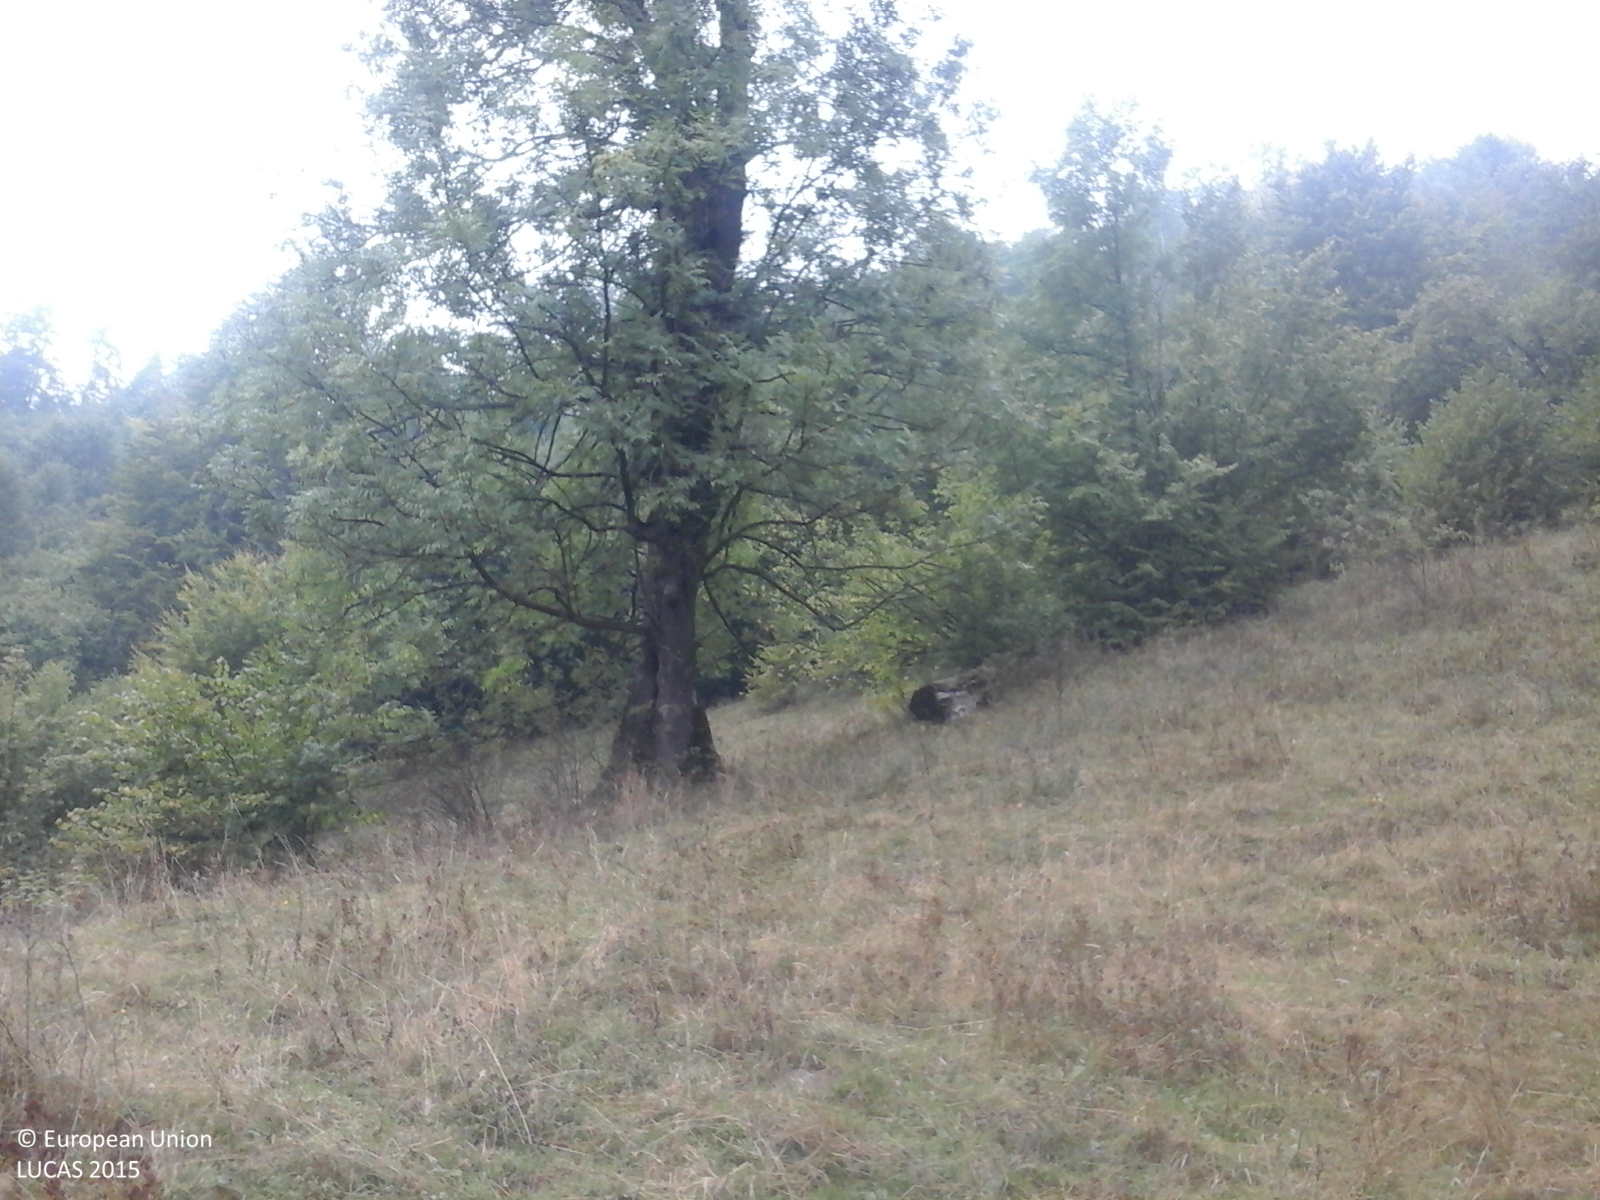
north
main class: Grassland
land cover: Grassland without tree/shrub cover
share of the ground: > 75 %
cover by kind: herbaceous plants 100 %
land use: Agriculture (excluding fallow land and kitchen gardens)
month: September
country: RO
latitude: 45.3690
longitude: 23.4530
